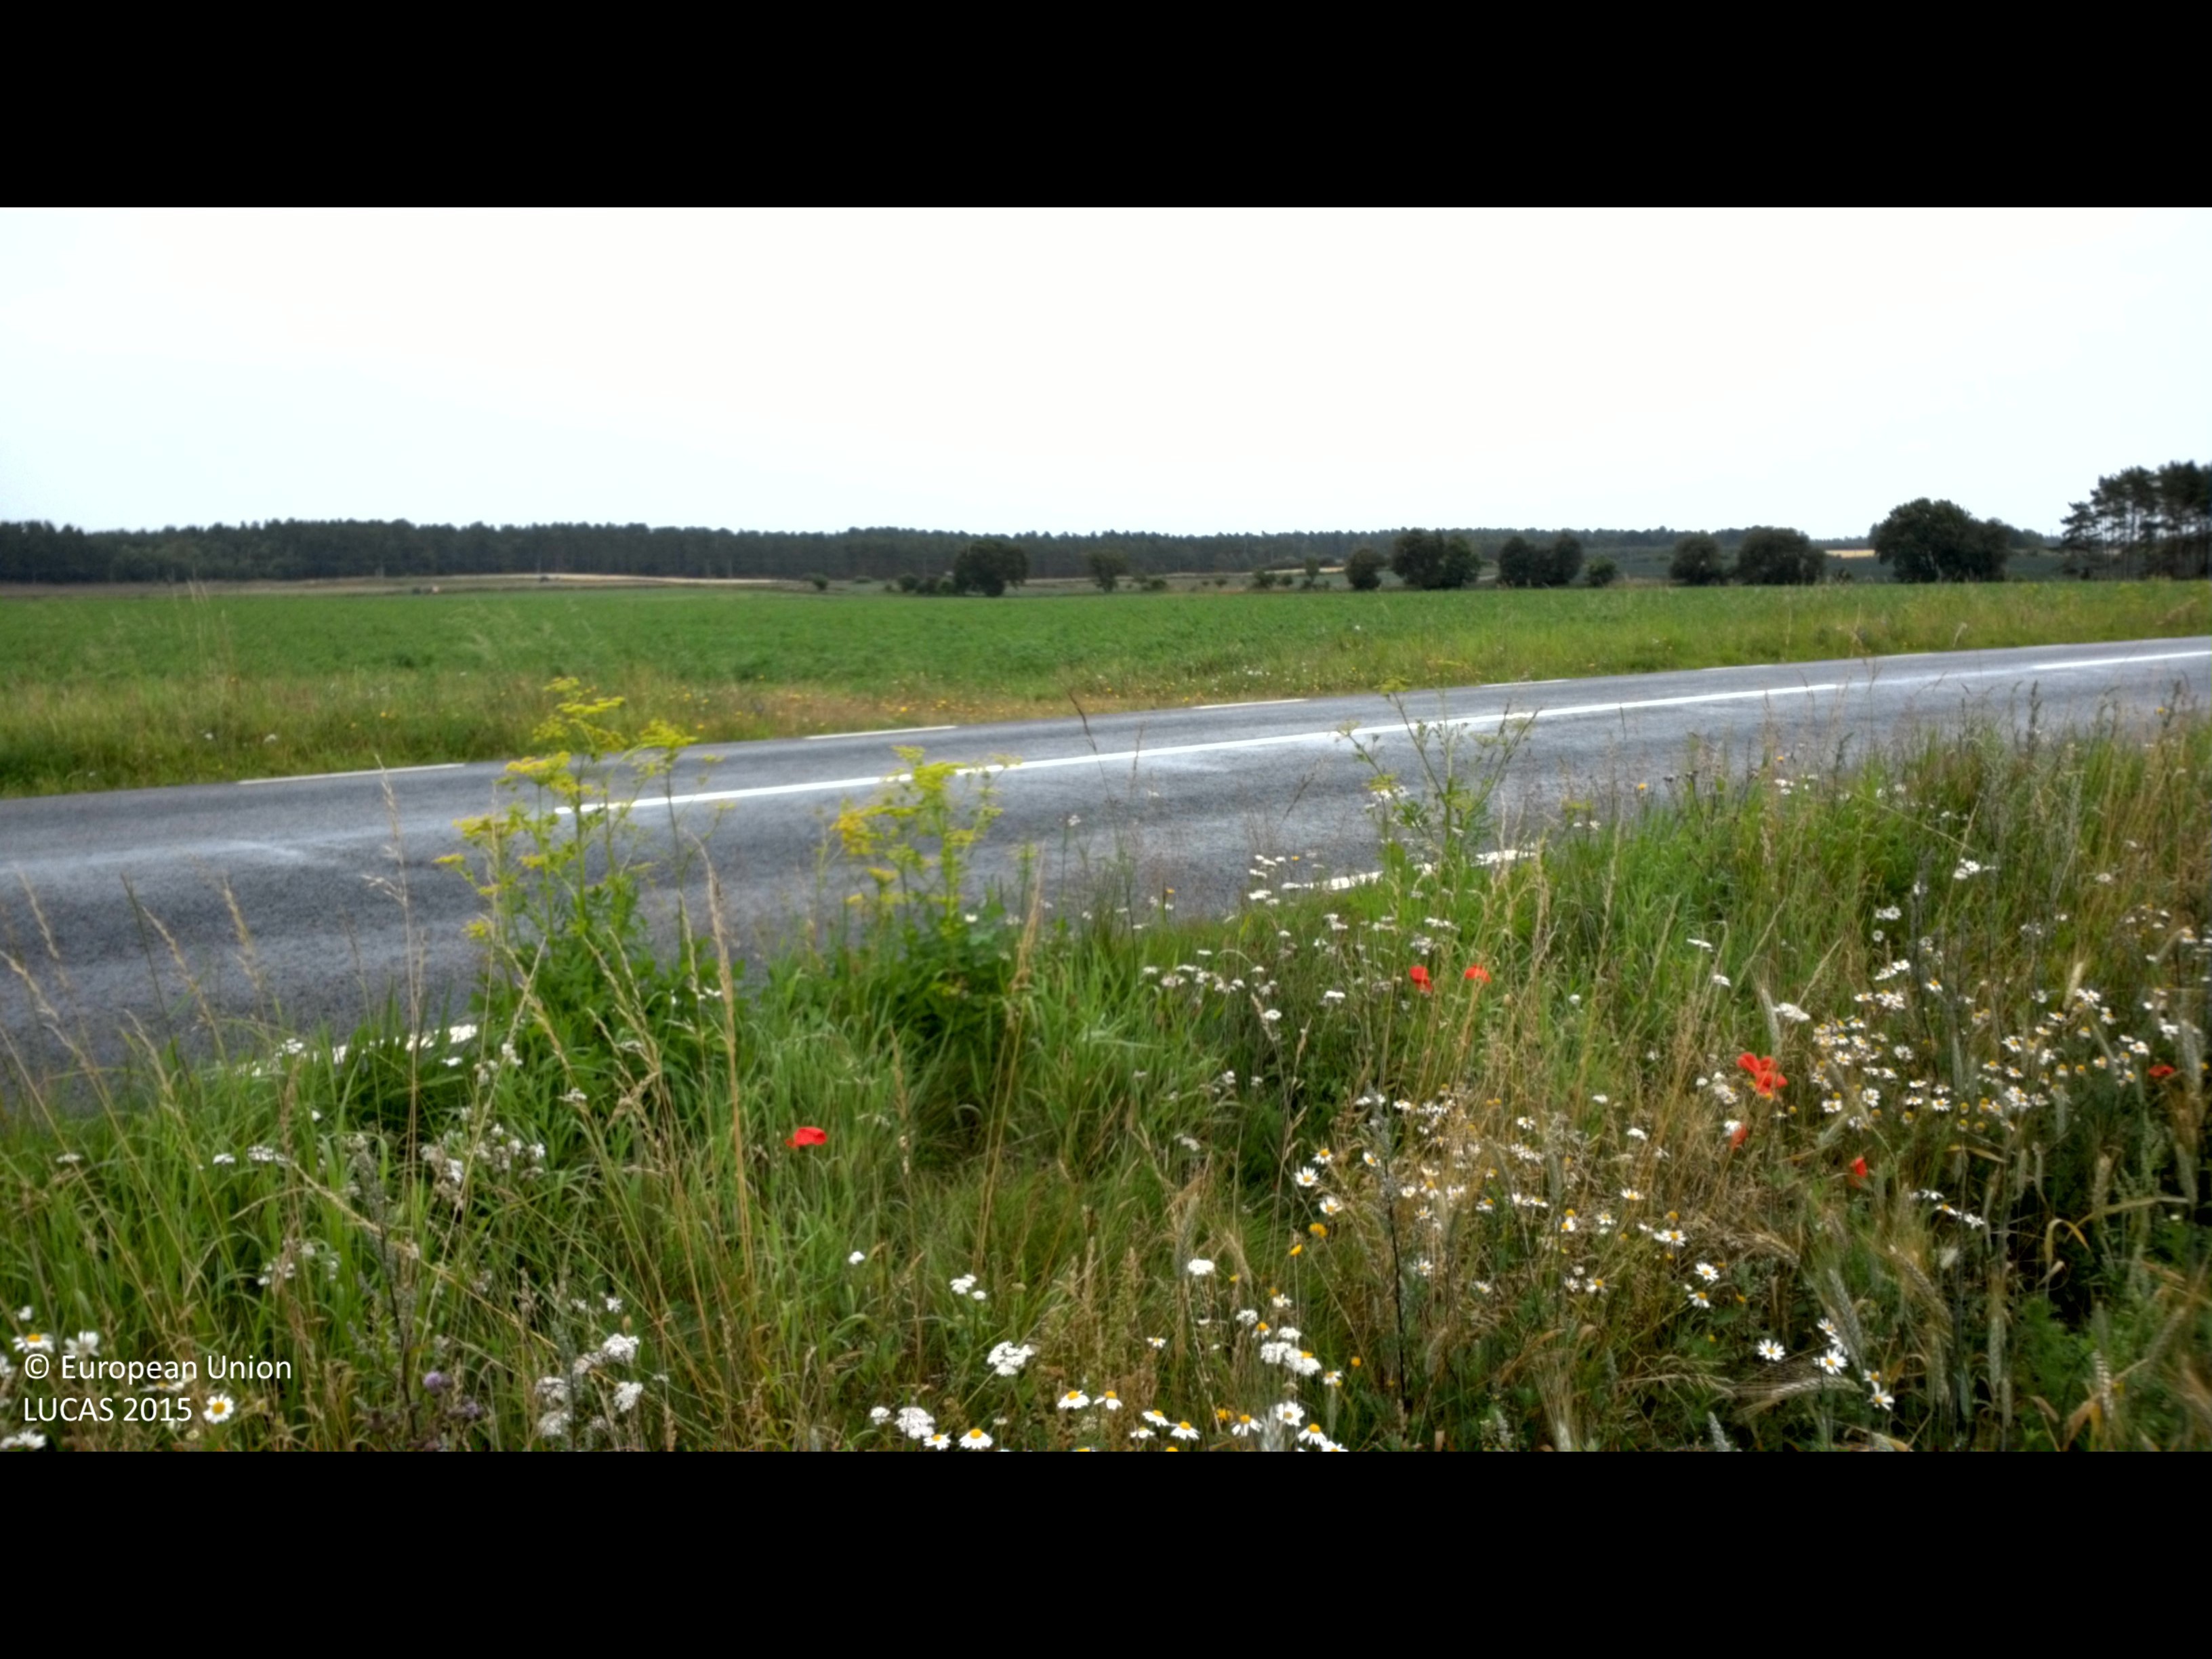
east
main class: Cropland
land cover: Rye
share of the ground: > 75 %
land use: Agriculture (excluding fallow land and kitchen gardens)
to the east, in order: Rye; Grass margins
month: July
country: SE
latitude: 55.8532
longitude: 14.0715
